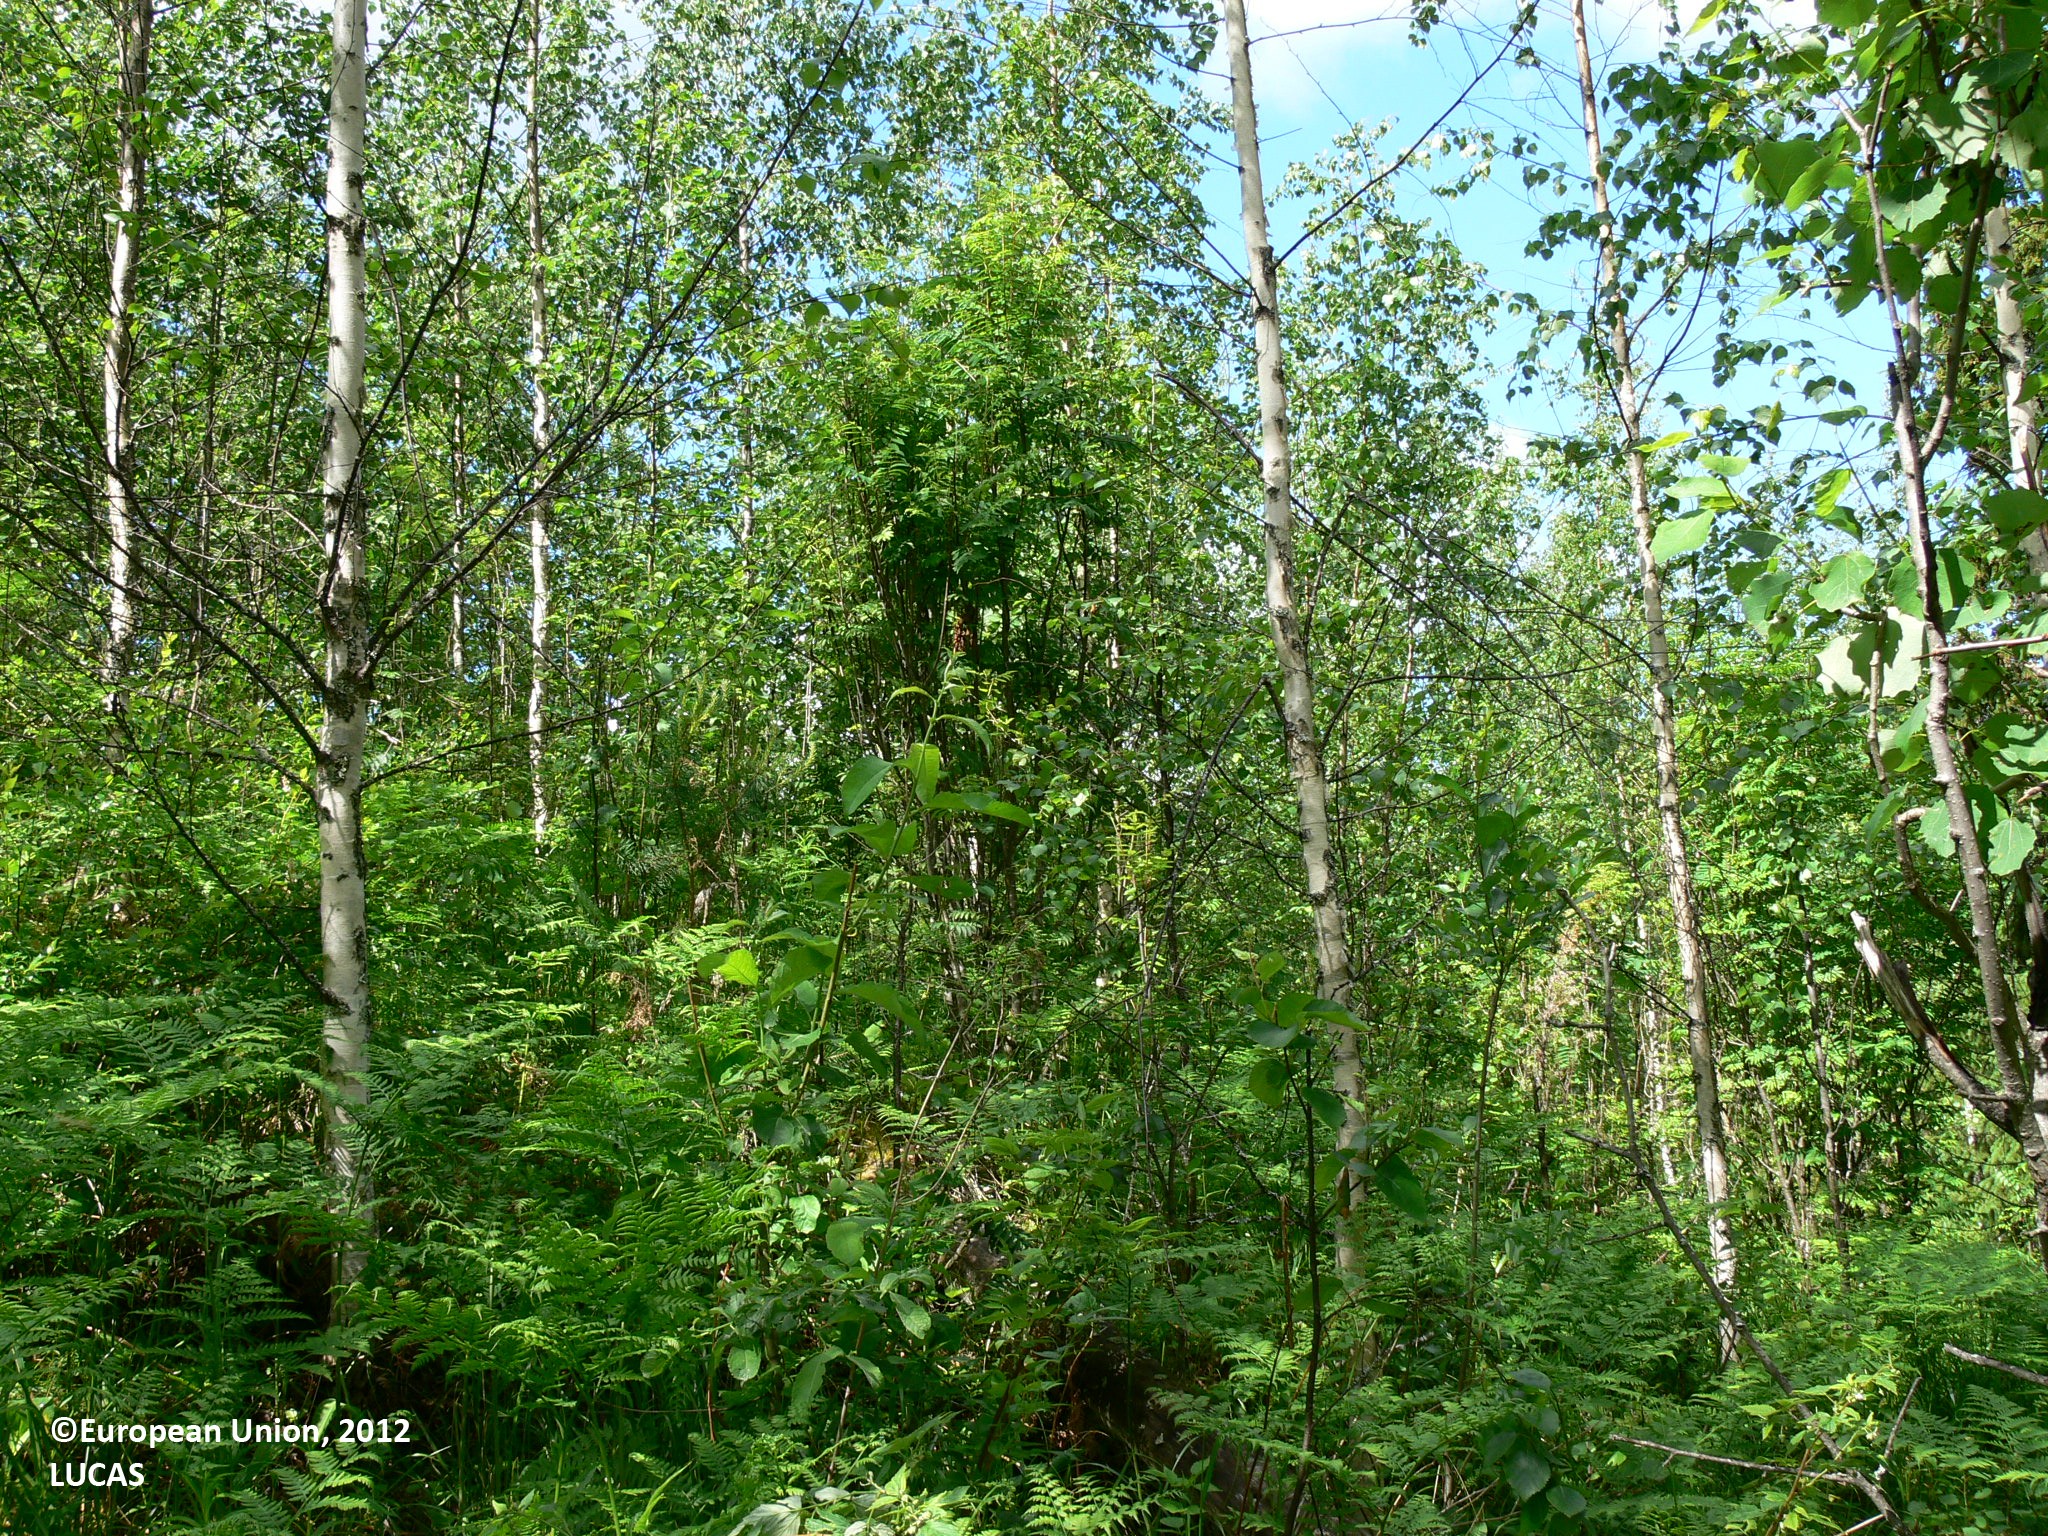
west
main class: Woodland
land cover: Broadleaved woodland
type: boreal forest
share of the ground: 50 - 75 %
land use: Forestry
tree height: > 5 m
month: June
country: FI
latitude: 62.3329
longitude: 30.1327
